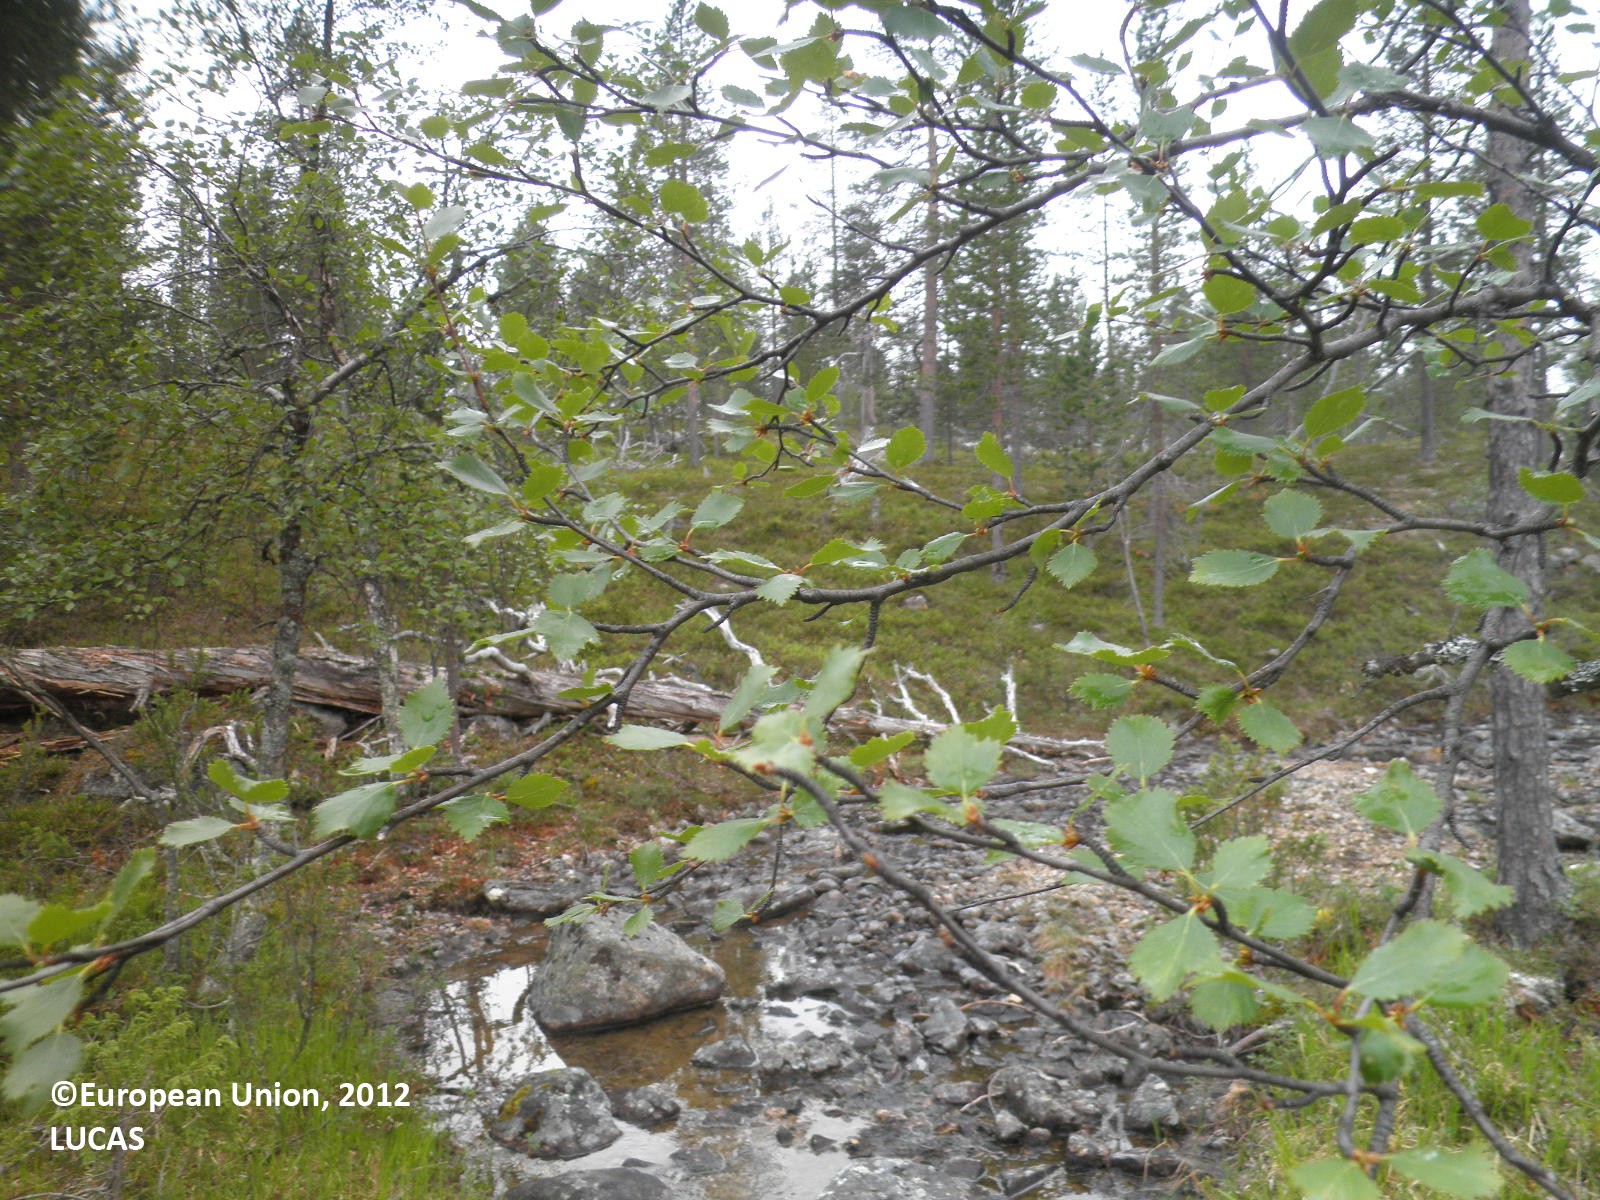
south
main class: Woodland
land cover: Pine dominated mixed woodland
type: boreal forest
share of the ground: 10 - 25 %
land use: Semi-natural and natural areas not in use
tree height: > 5 m
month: July
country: FI
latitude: 68.5411
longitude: 27.7463
